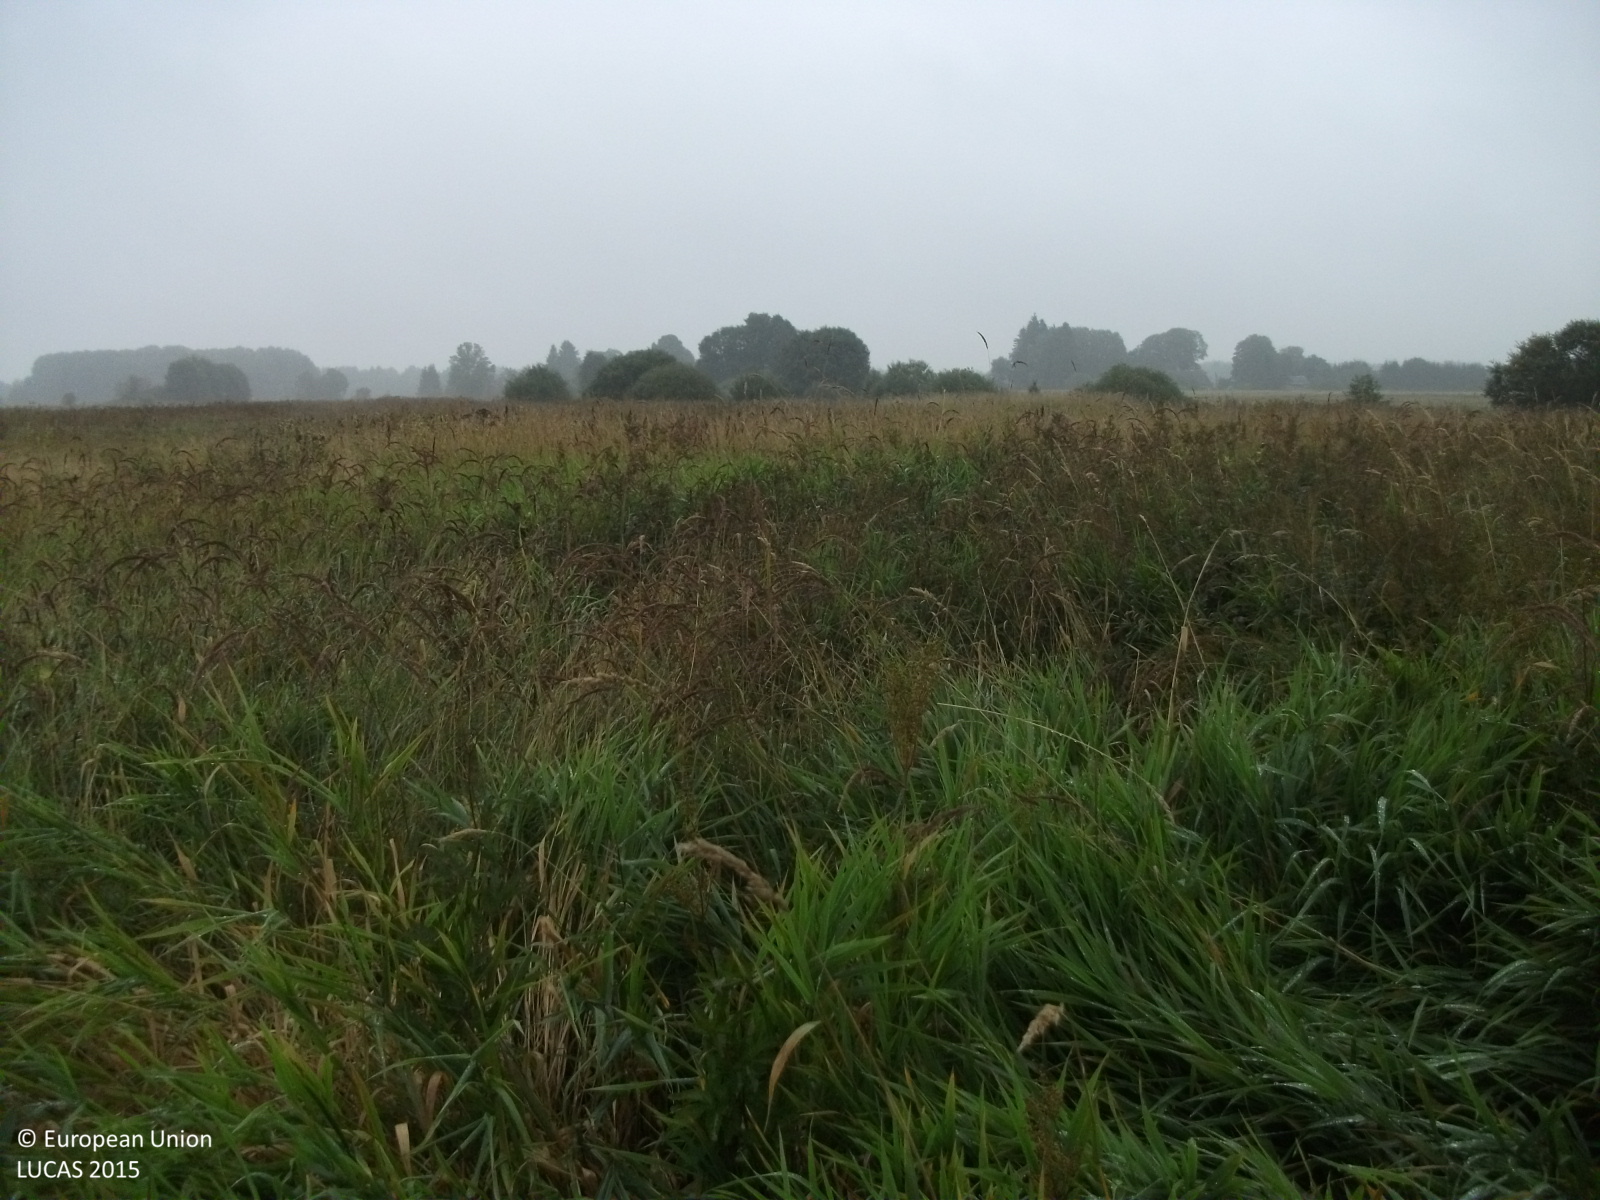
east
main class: Grassland
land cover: Grassland without tree/shrub cover
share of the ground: > 75 %
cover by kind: herbaceous plants 100 %
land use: Agriculture (excluding fallow land and kitchen gardens)
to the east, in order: Grassland without tree/shrub cover; Grassland with sparse tree/shrub cover; Spontaneously vegetated surfaces
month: September
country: LV
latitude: 57.5042
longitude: 24.6302
